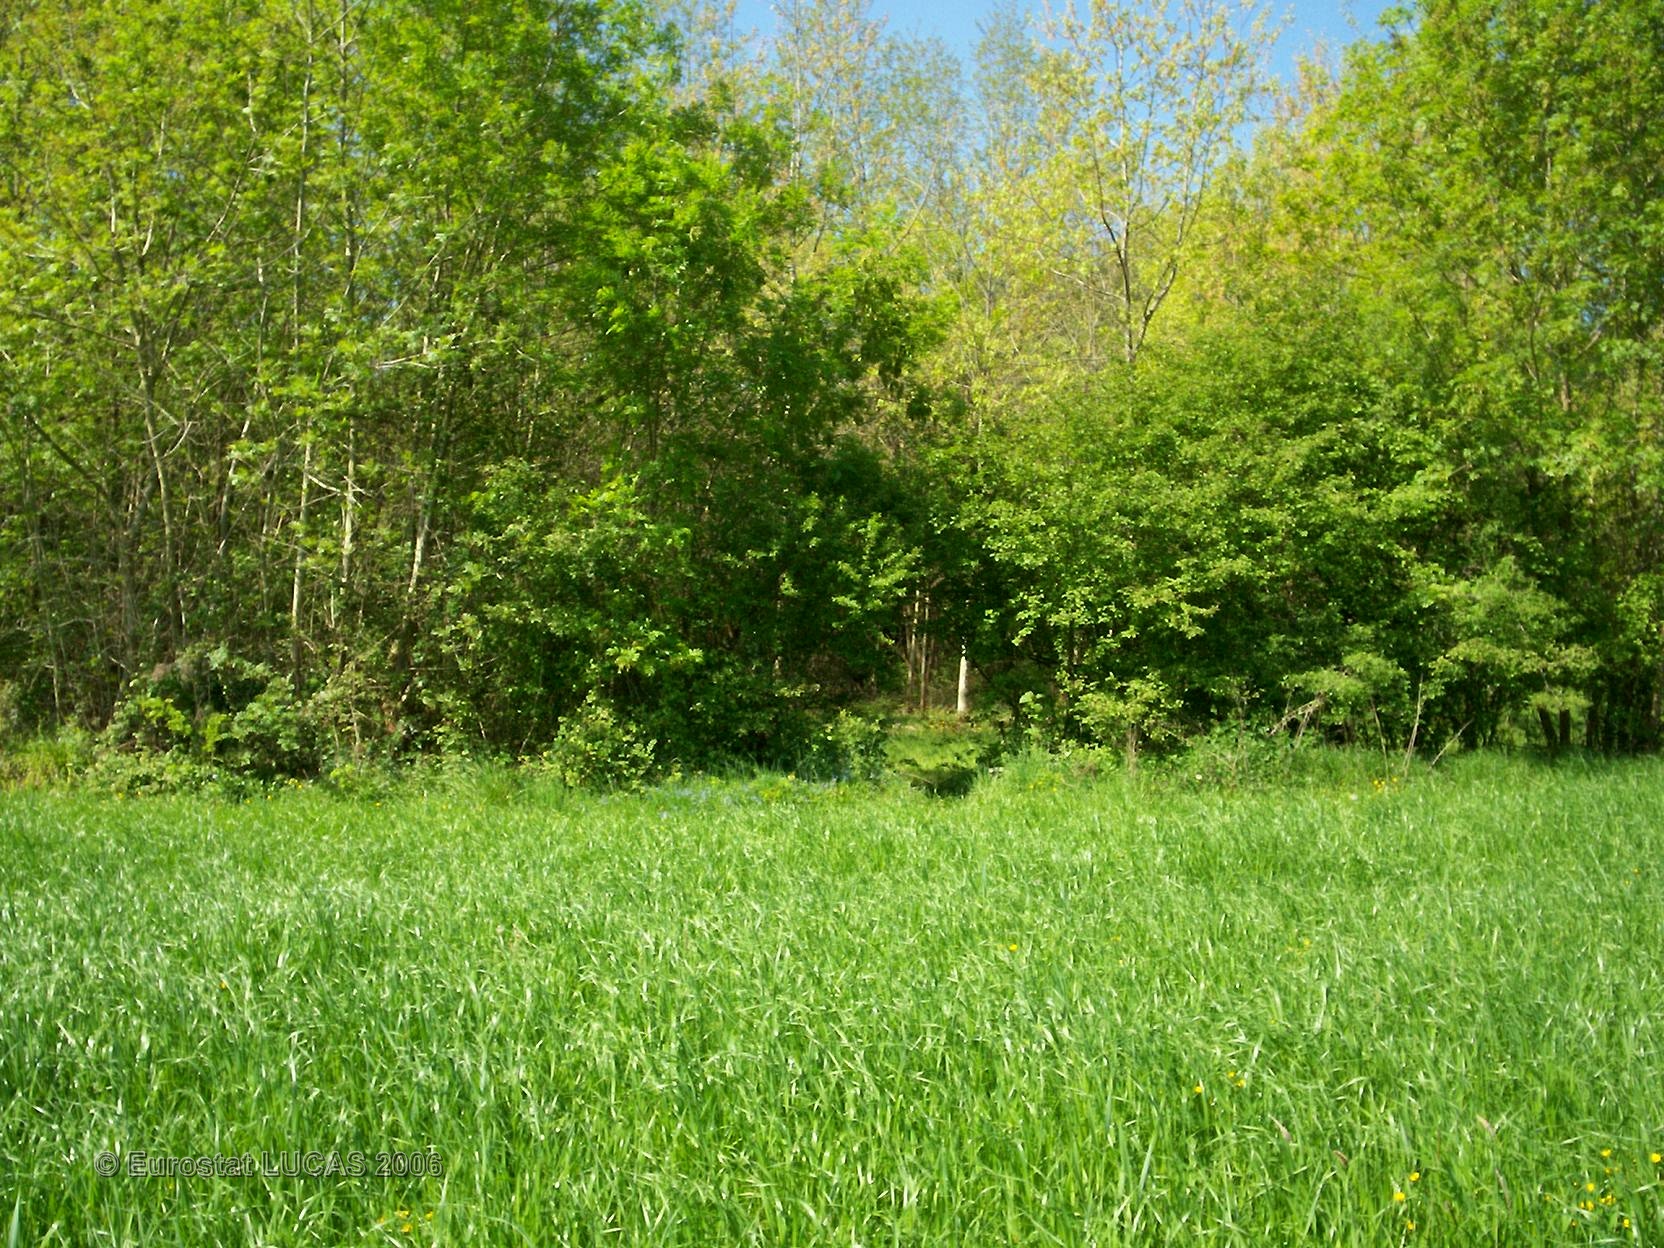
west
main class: Grassland
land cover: Grassland without tree/shrub cover
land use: Agriculture (excluding fallow land and kitchen gardens)
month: April
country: FR
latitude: 43.3840
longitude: -0.6376
